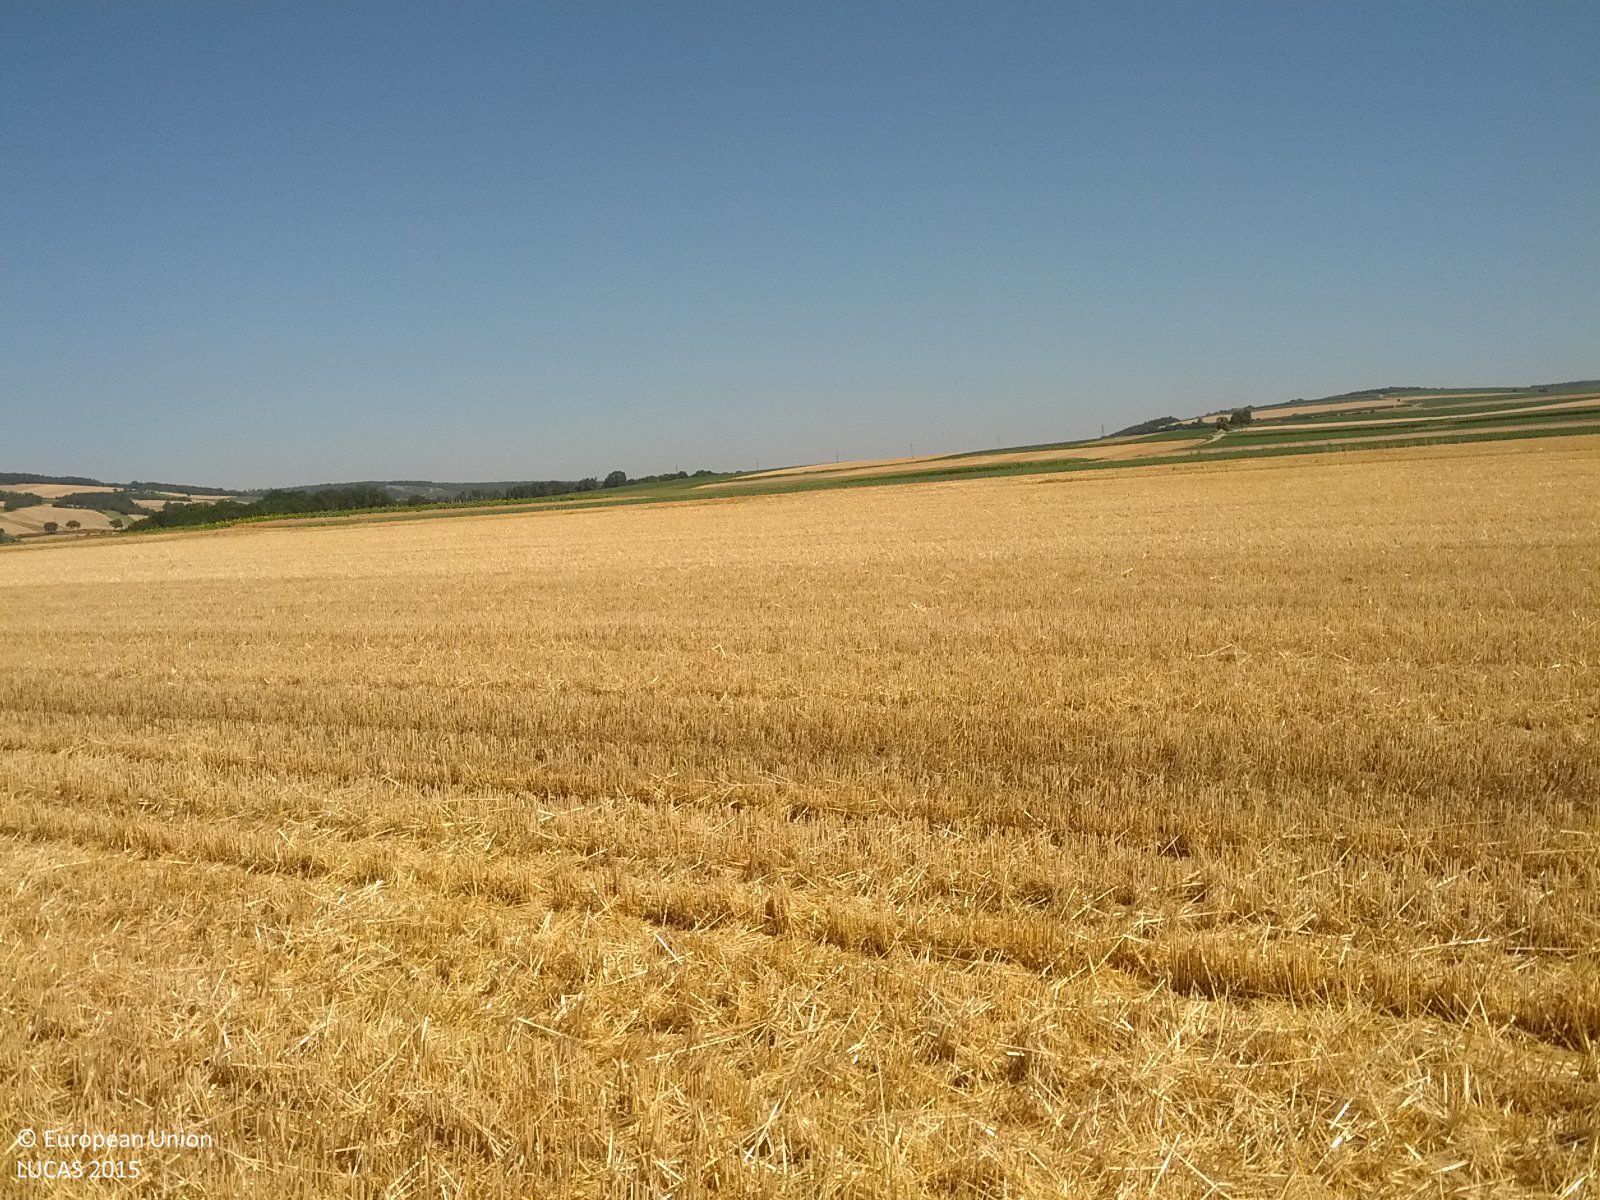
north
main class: Cropland
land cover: Common wheat
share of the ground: > 75 %
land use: Agriculture (excluding fallow land and kitchen gardens)
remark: Harvested field
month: July
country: AT
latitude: 48.4843
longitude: 16.1607
